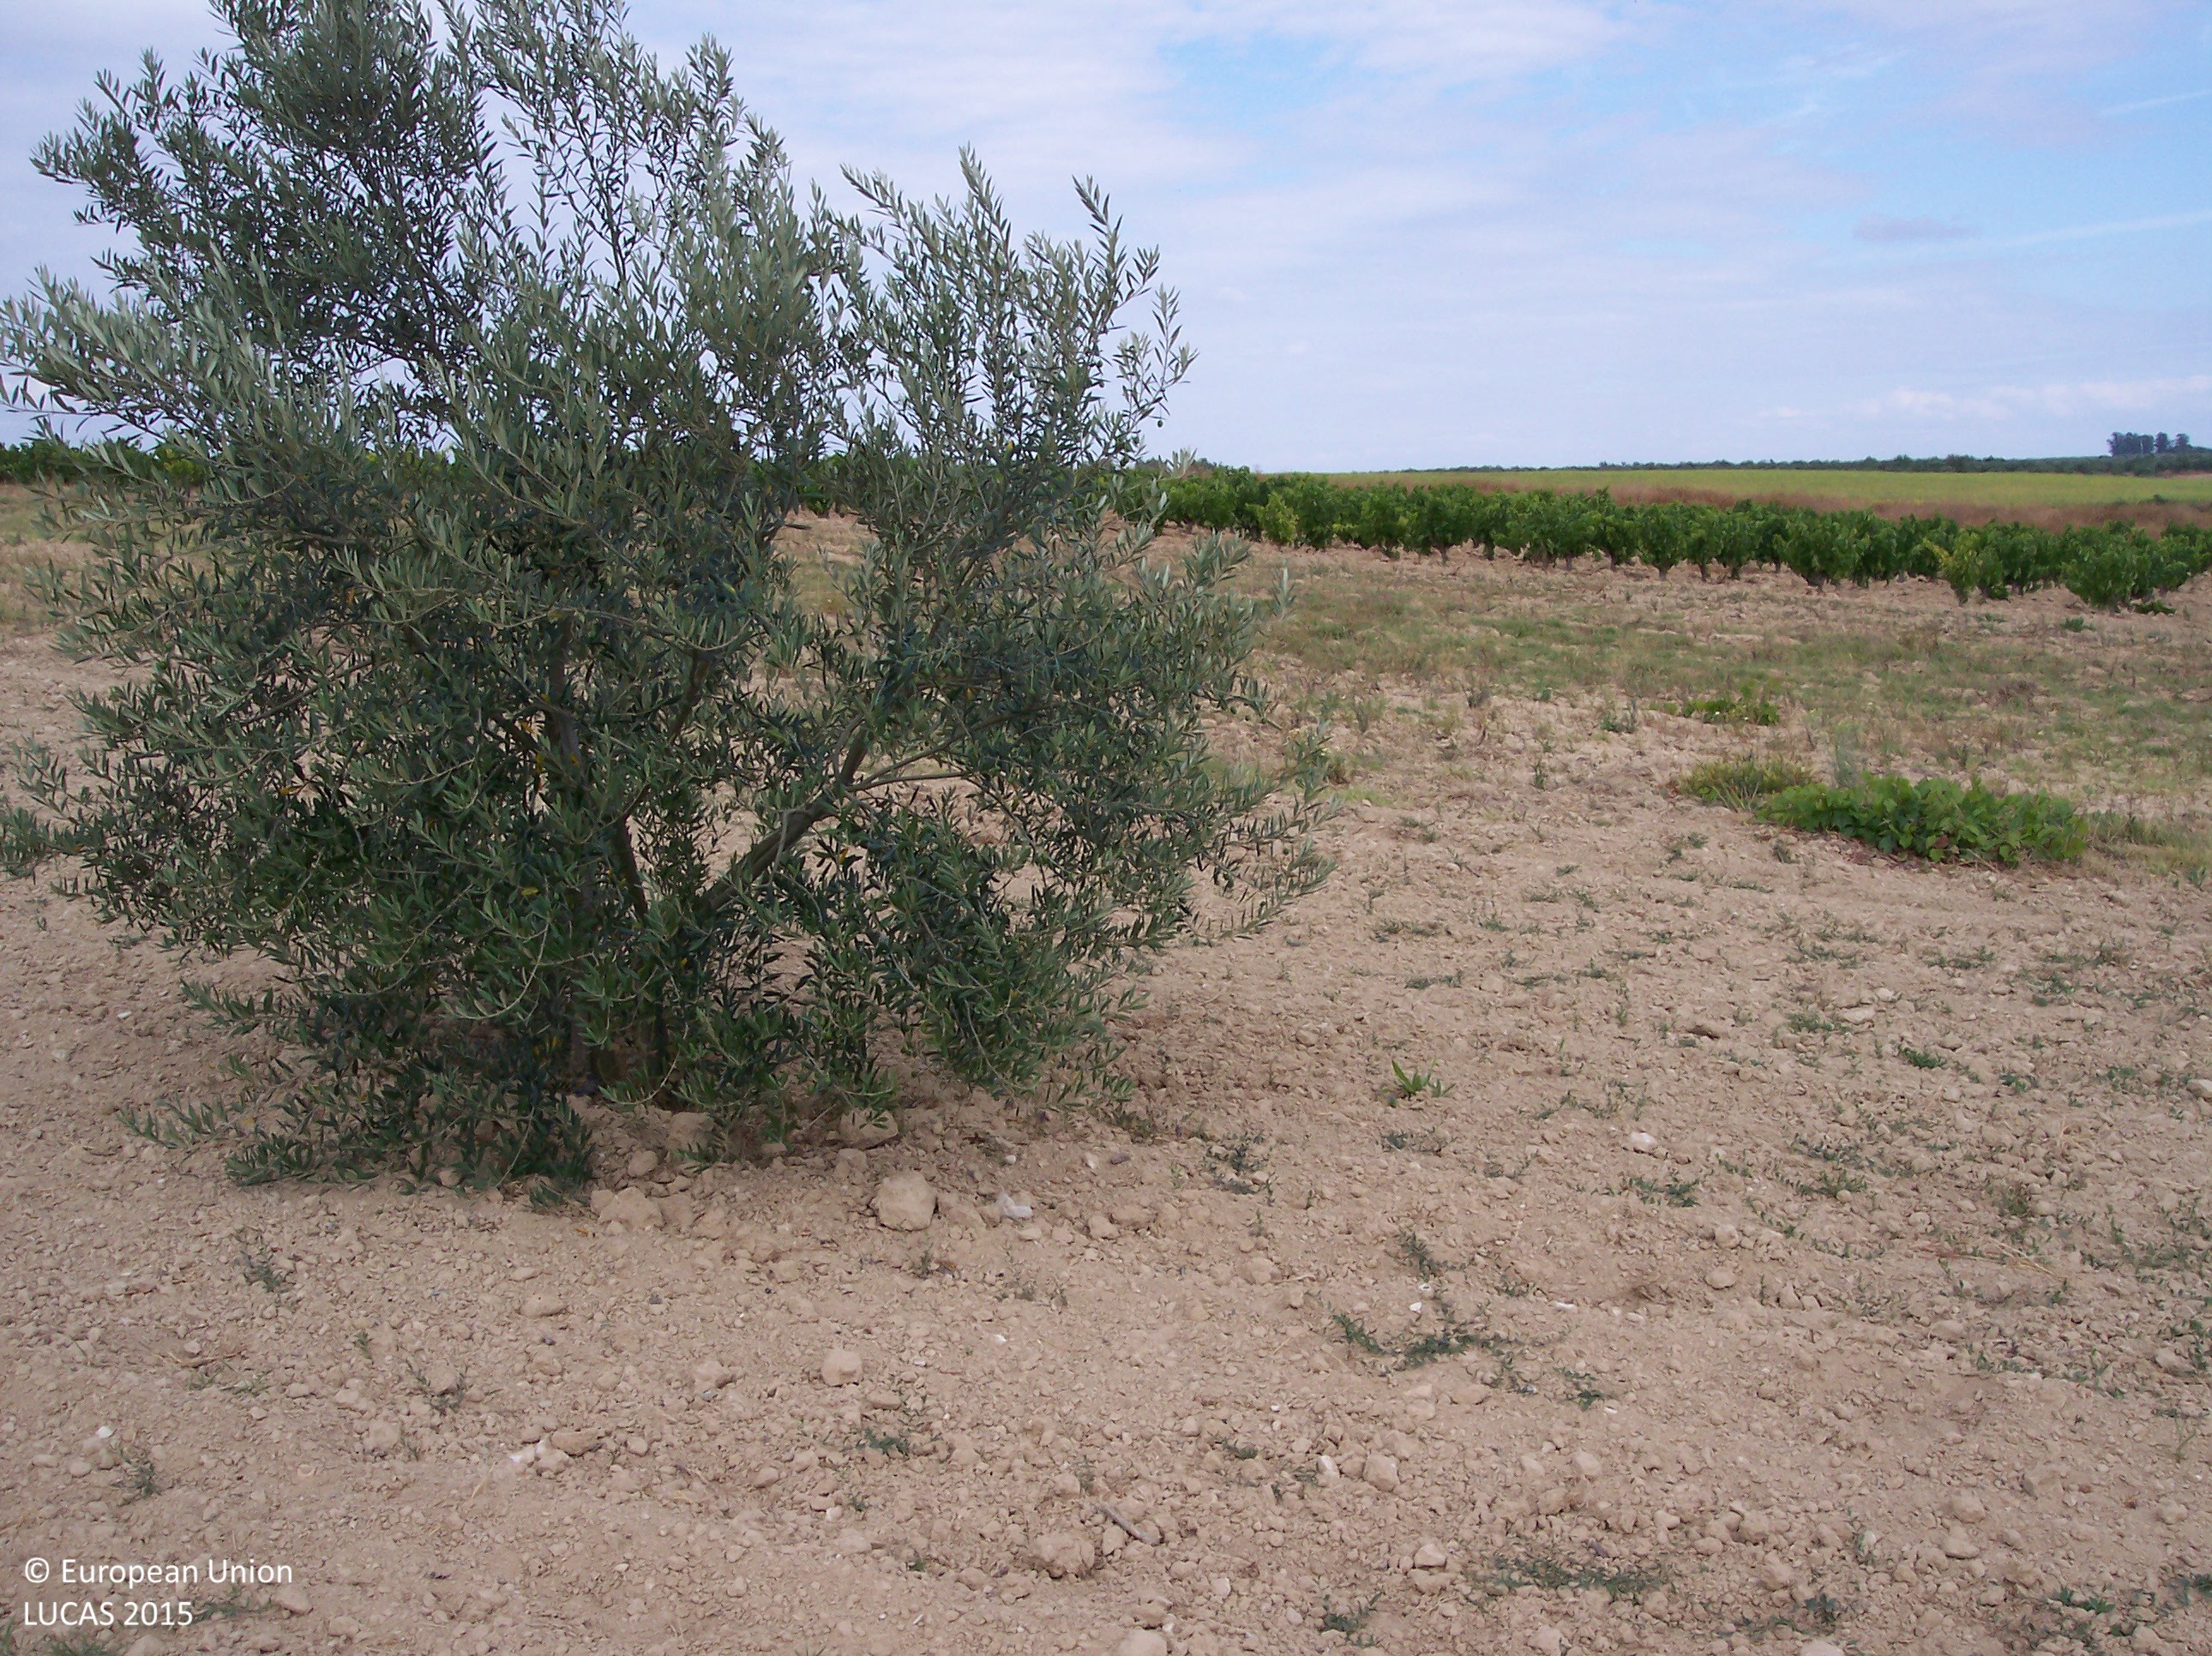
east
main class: Cropland
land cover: Olive groves
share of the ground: 10 - 25 %
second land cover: Other bare soil
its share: > 75 %
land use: Agriculture (excluding fallow land and kitchen gardens)
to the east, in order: Olive groves; Other bare soil; Spontaneously vegetated surfaces; Vineyards; Tracks; Spontaneously vegetated surfaces; Sunflower; Grass margins; Fences; Durum wheat; Fences; Abandoned hedges; Rivers and streams; Abandoned hedges; Olive groves
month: June
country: ES
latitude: 37.2548
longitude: -6.5023
